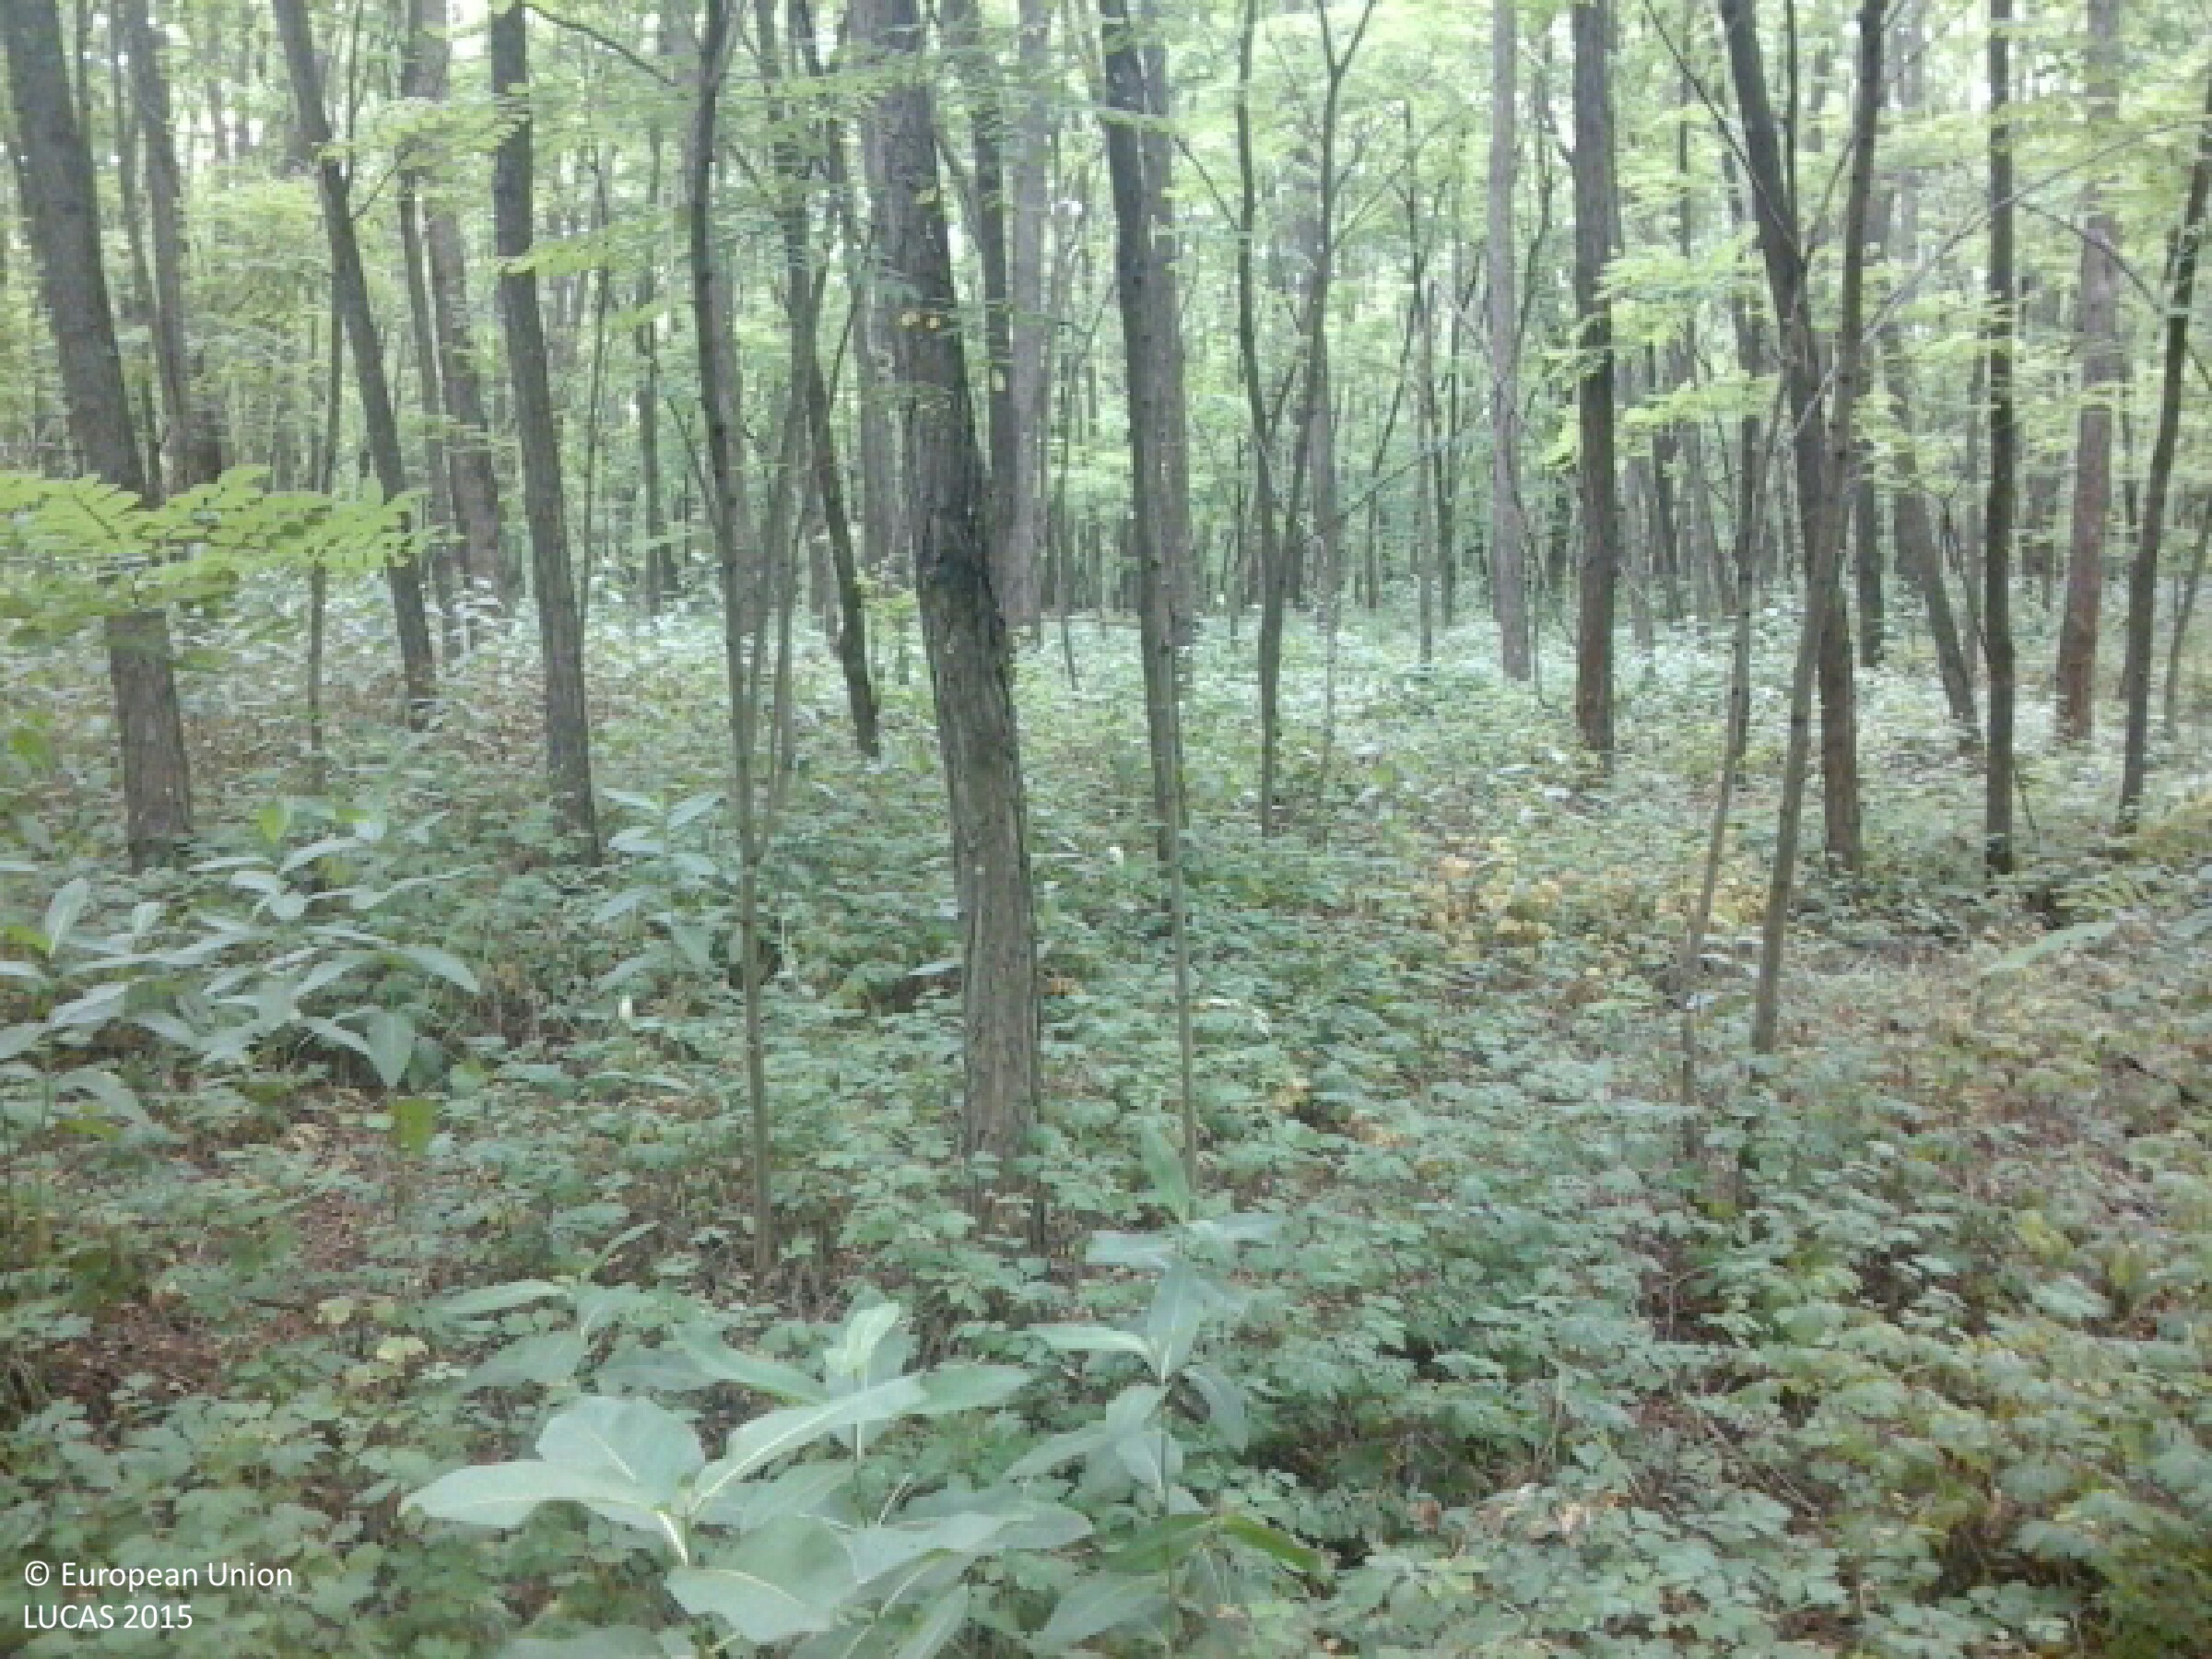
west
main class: Woodland
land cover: Broadleaved woodland
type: exotic forest
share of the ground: > 75 %
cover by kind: broadleaved forest trees 80 %, herbaceous plants 15 %, shrubs 5 %
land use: Forestry
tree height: > 5 m
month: June
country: HU
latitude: 48.1060
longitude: 22.2098
